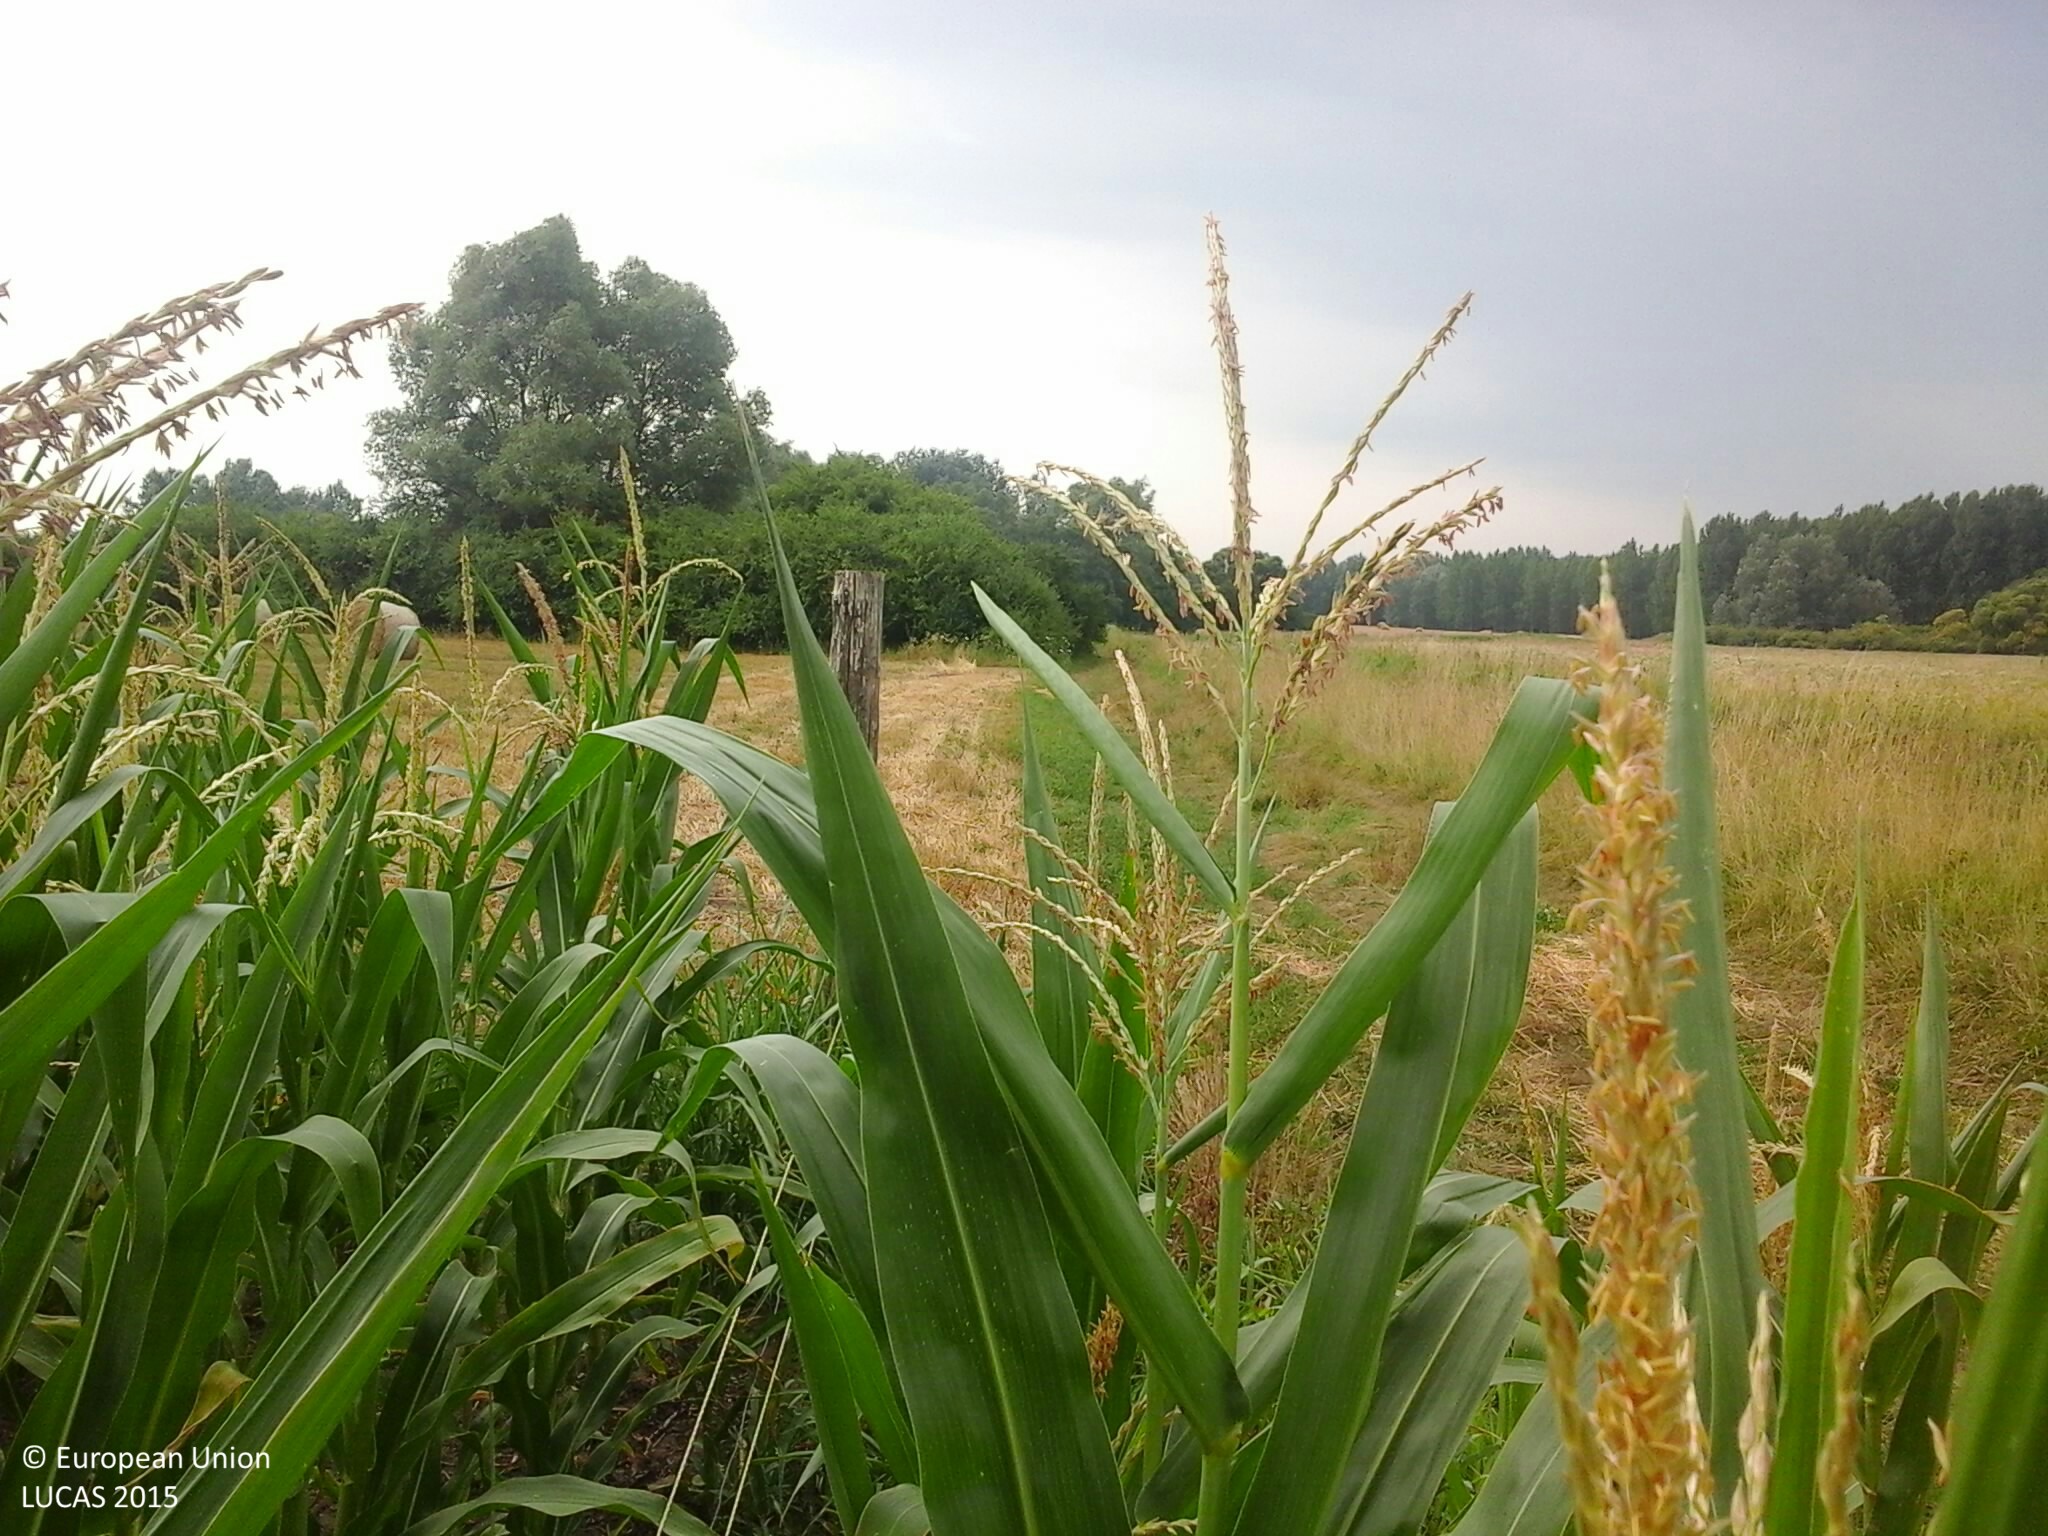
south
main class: Cropland
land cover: Maize
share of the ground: > 75 %
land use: Agriculture (excluding fallow land and kitchen gardens)
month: July
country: HU
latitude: 47.6867
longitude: 22.2170
